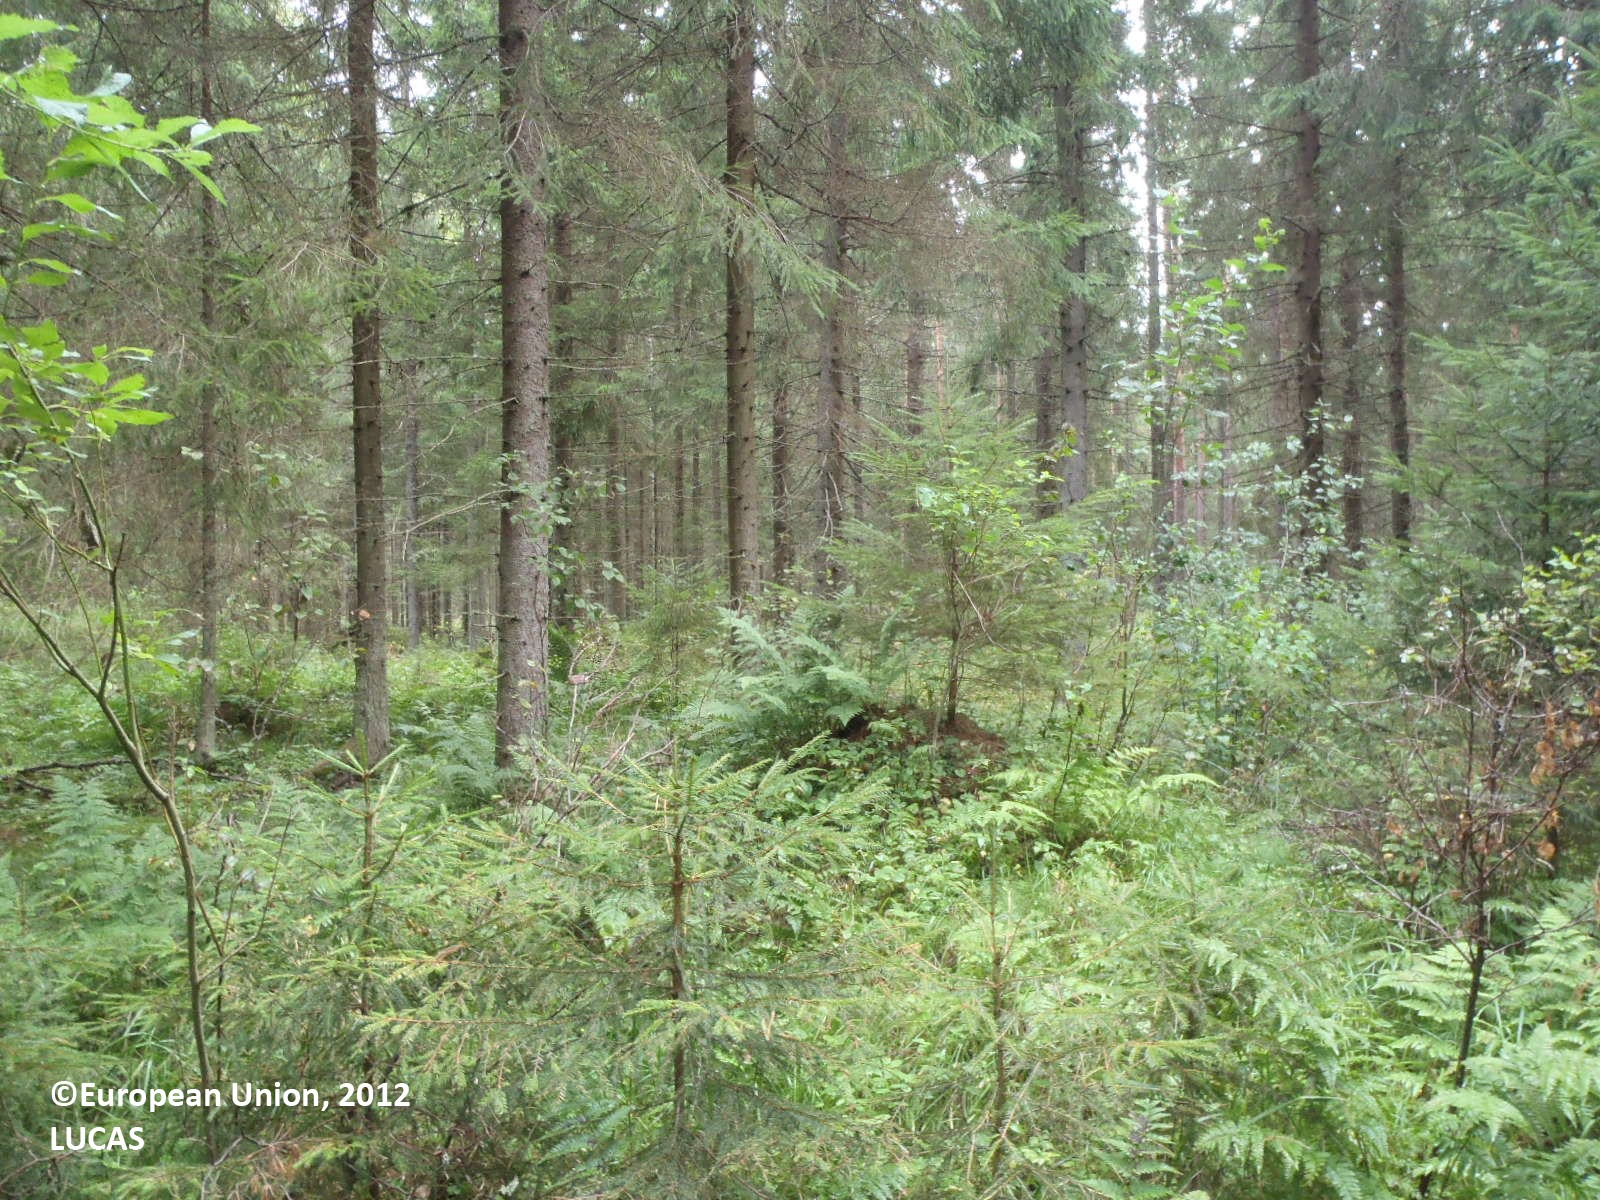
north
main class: Woodland
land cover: Spruce dominated coniferous woodland
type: boreal forest
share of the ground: > 75 %
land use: Forestry
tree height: > 5 m
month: August
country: FI
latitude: 60.6604
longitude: 22.5292
